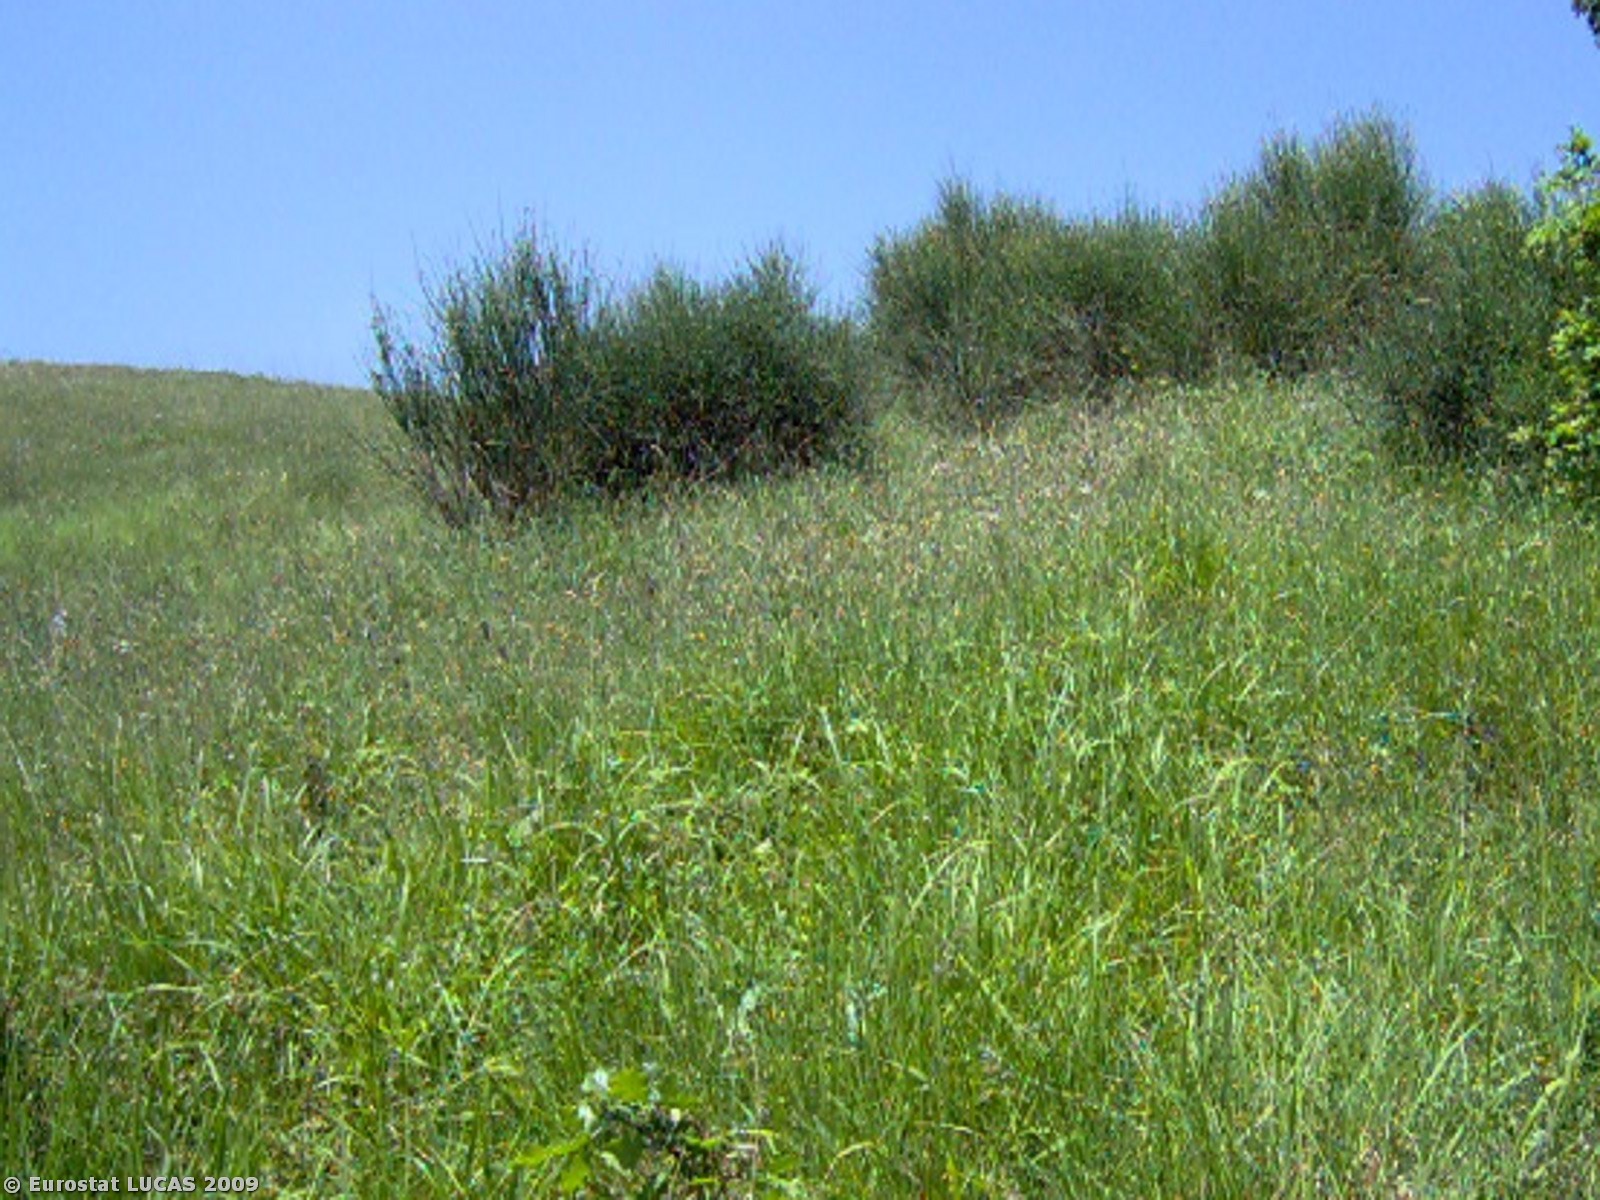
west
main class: Cropland
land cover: Mixed cereals for fodder
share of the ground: > 75 %
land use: Agriculture (excluding fallow land and kitchen gardens)
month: May
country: IT
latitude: 40.5808
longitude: 15.5658
